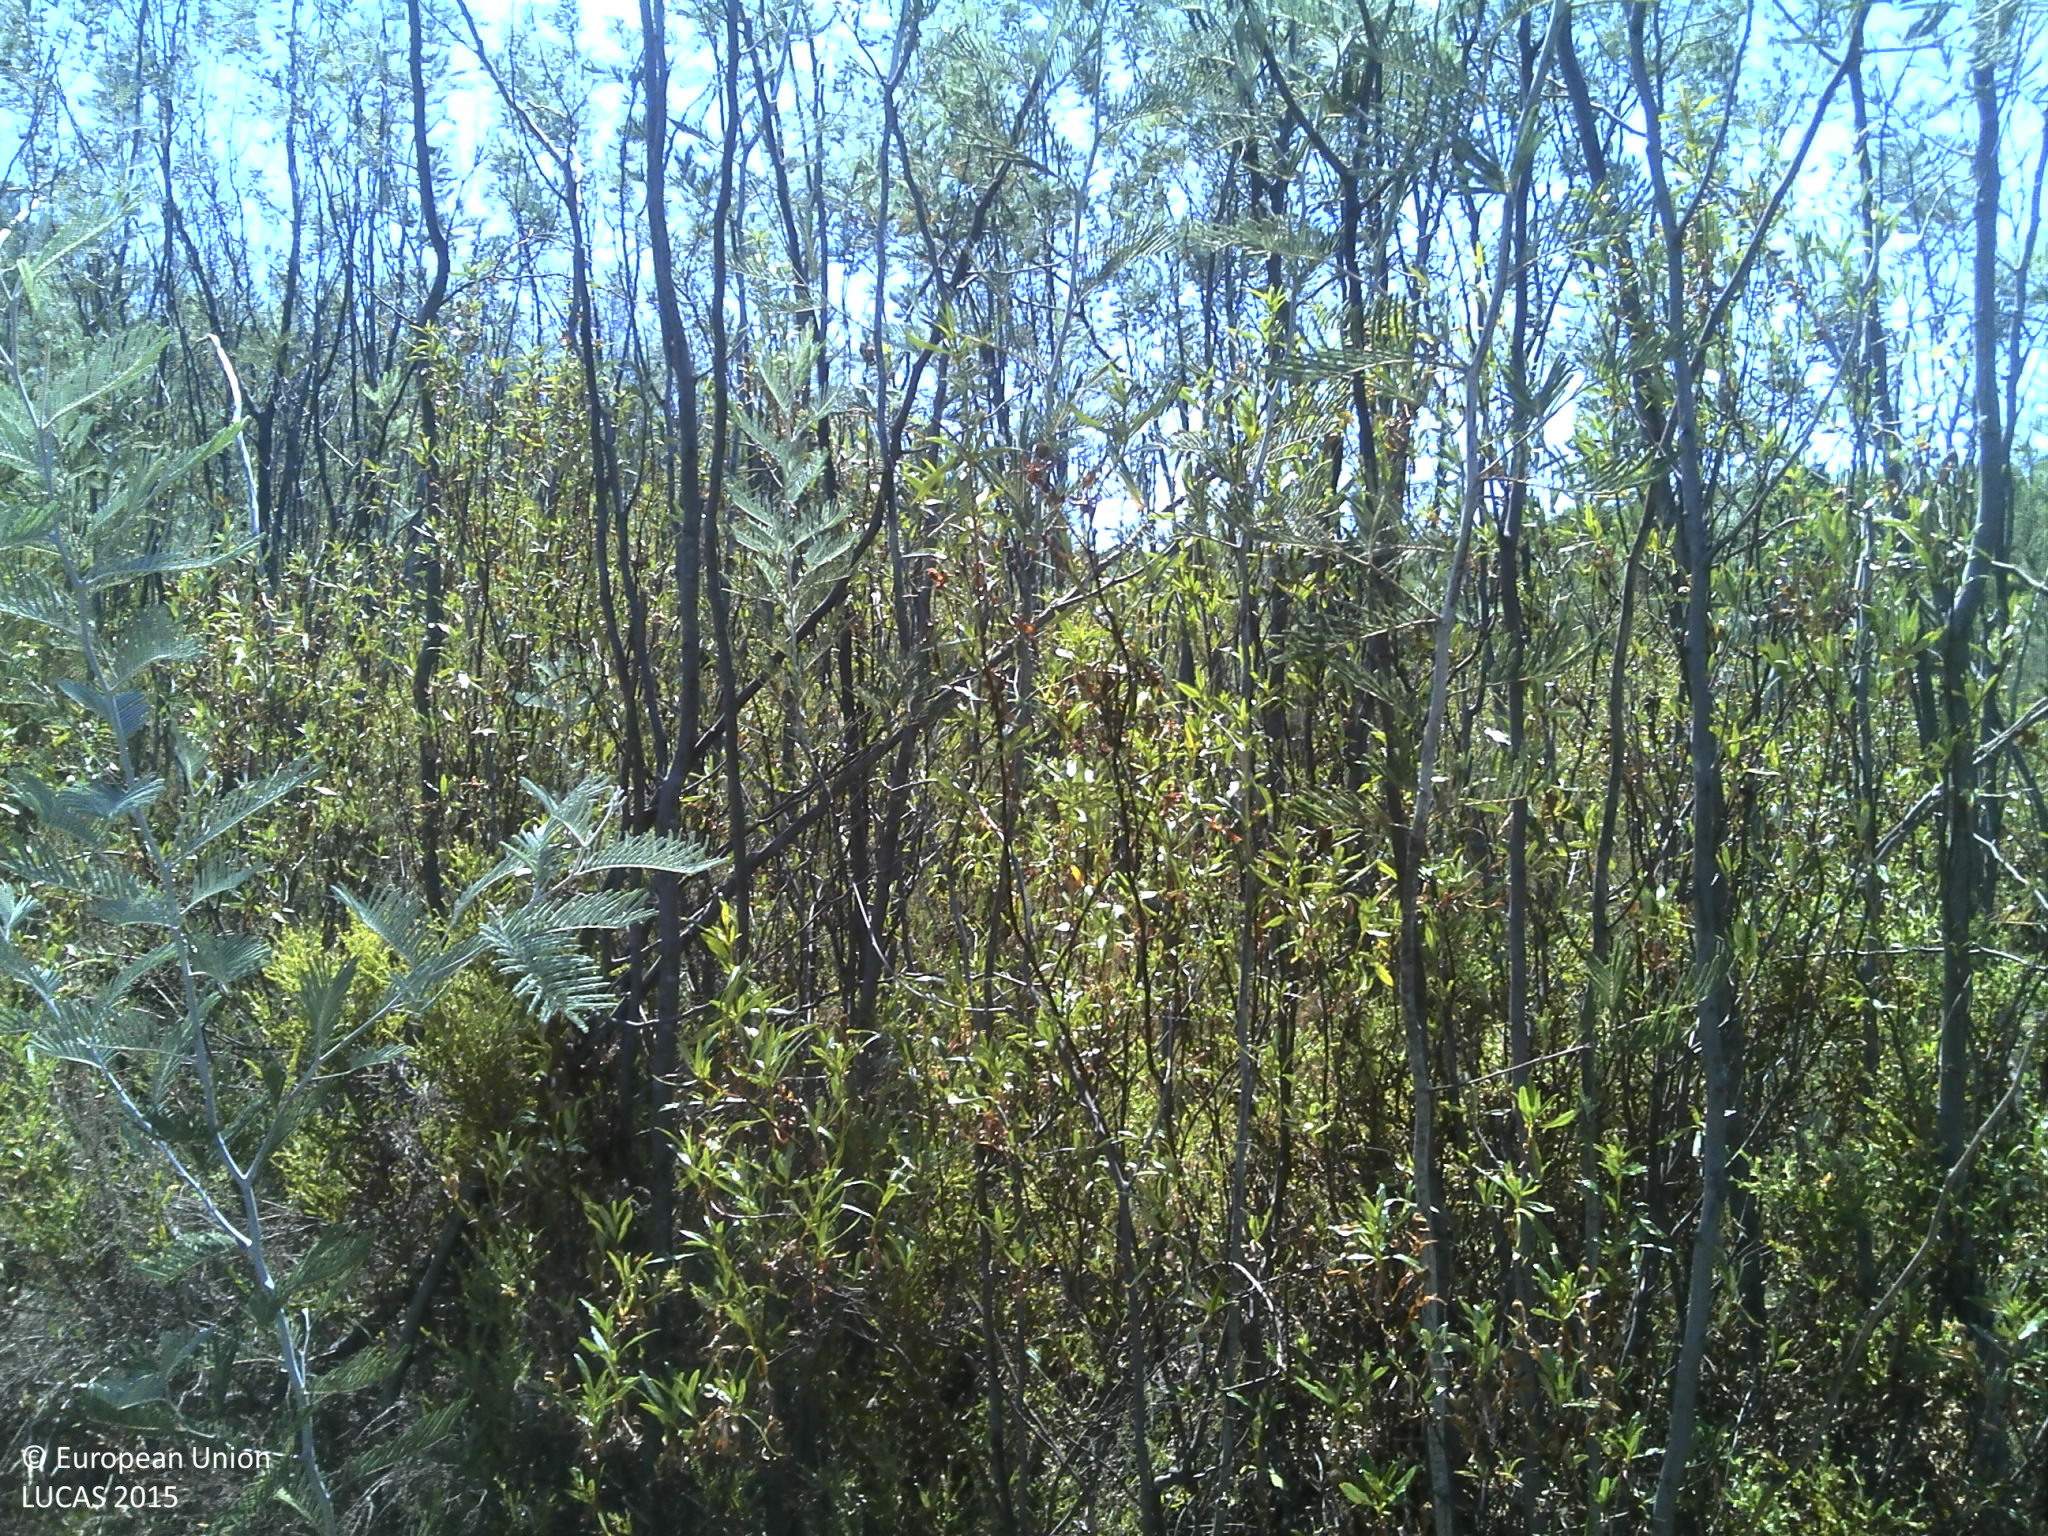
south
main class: Shrubland
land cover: Shrubland without tree cover
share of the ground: 50 - 75 %
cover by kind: shrubs 70 %, unconsolidated bare surface 20 %, herbaceous plants 10 %
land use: Abandoned areas
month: July
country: PT
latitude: 40.1470
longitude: -7.6579
